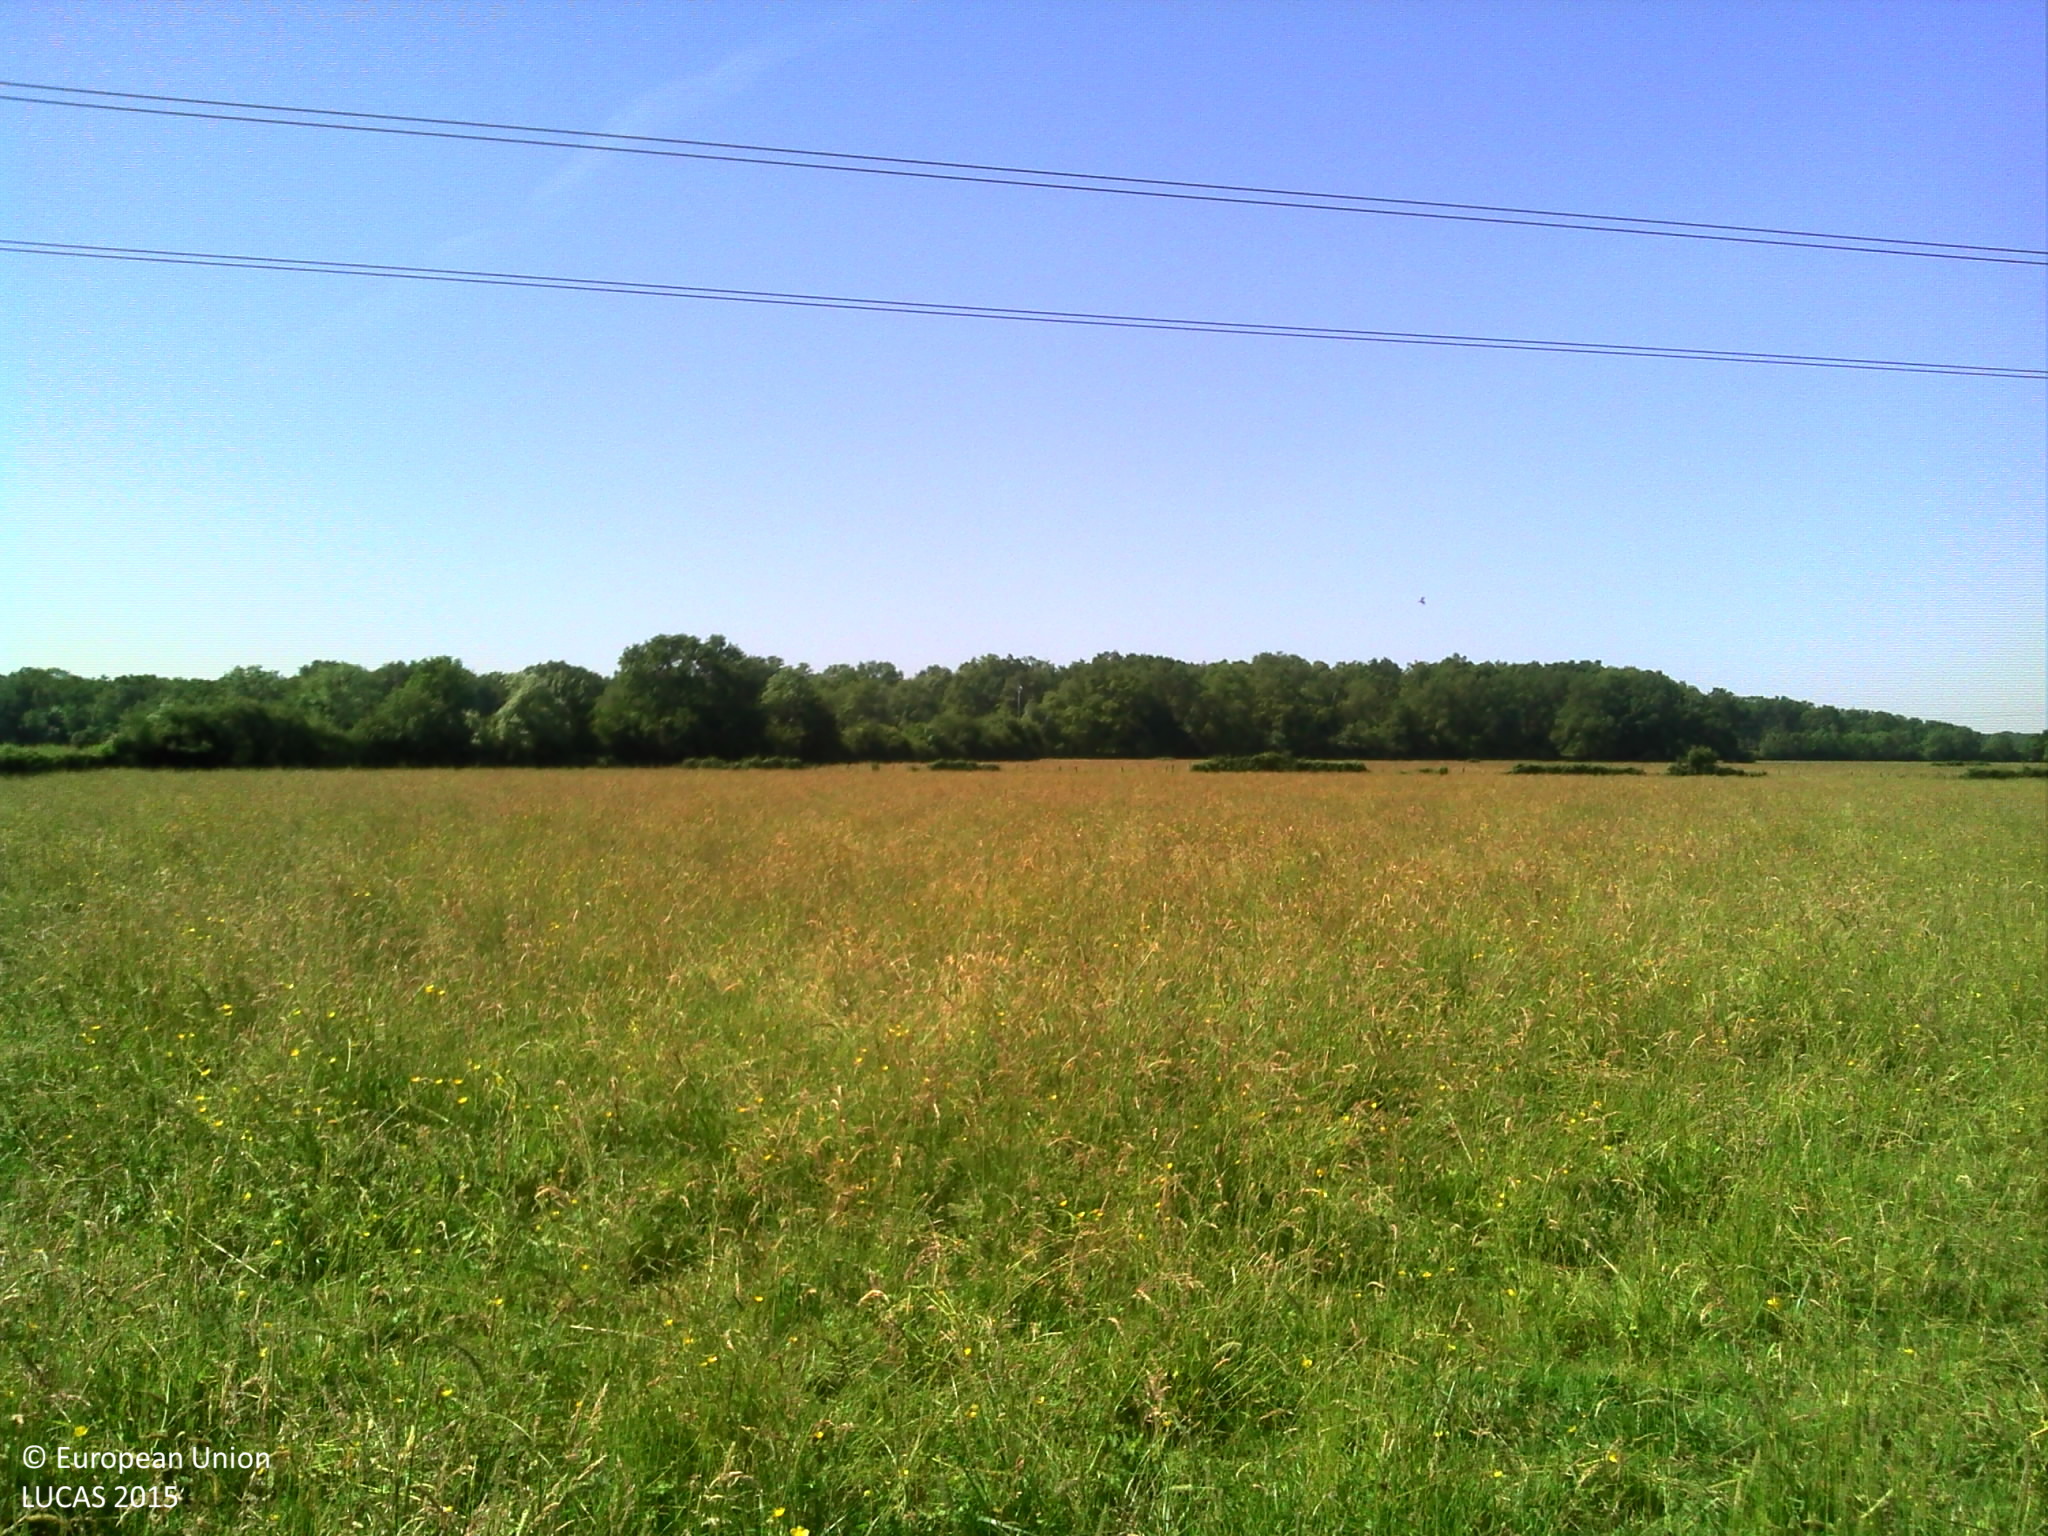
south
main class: Grassland
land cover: Grassland without tree/shrub cover
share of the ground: > 75 %
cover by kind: herbaceous plants 100 %
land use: Agriculture (excluding fallow land and kitchen gardens)
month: June
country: FR
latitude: 46.6393
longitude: 4.7891
